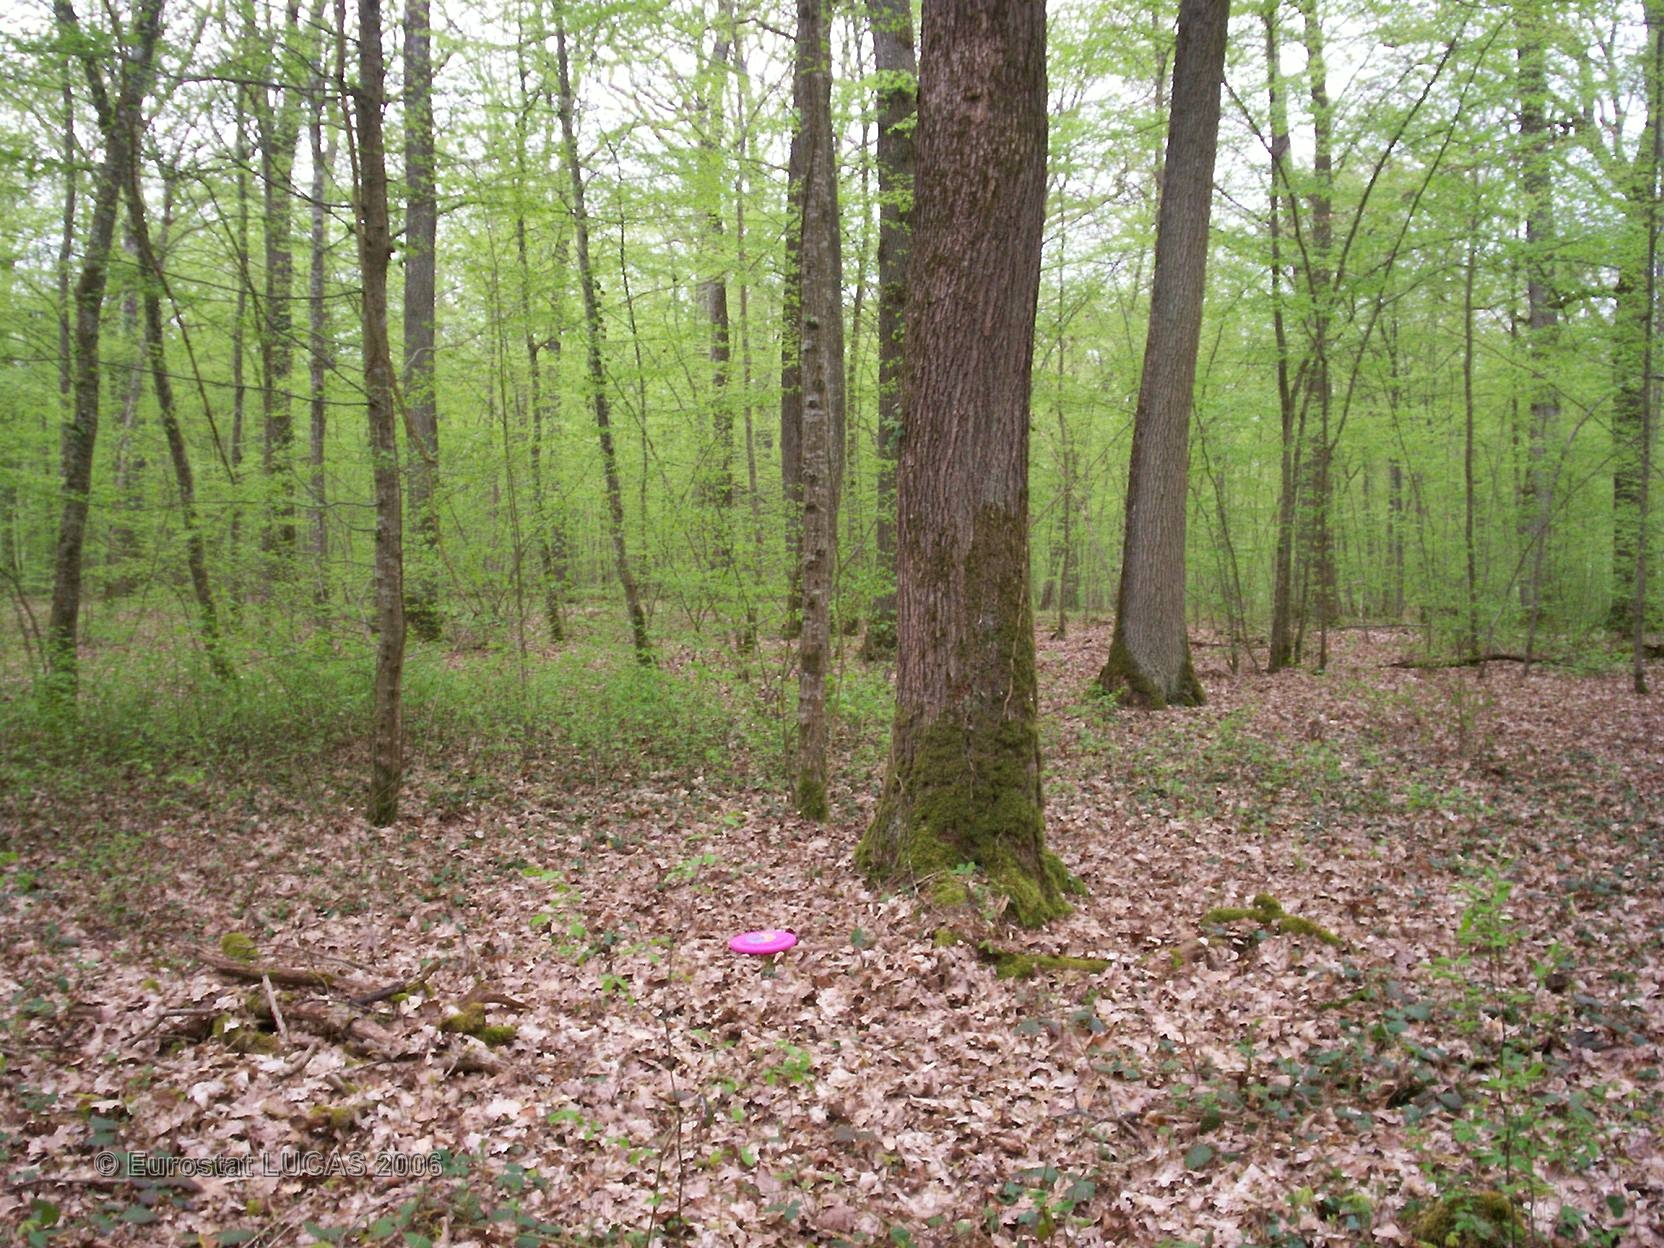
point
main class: Woodland
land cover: Broadleaved forest
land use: Forestry
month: April
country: FR
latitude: 48.3309
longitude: 5.9940
